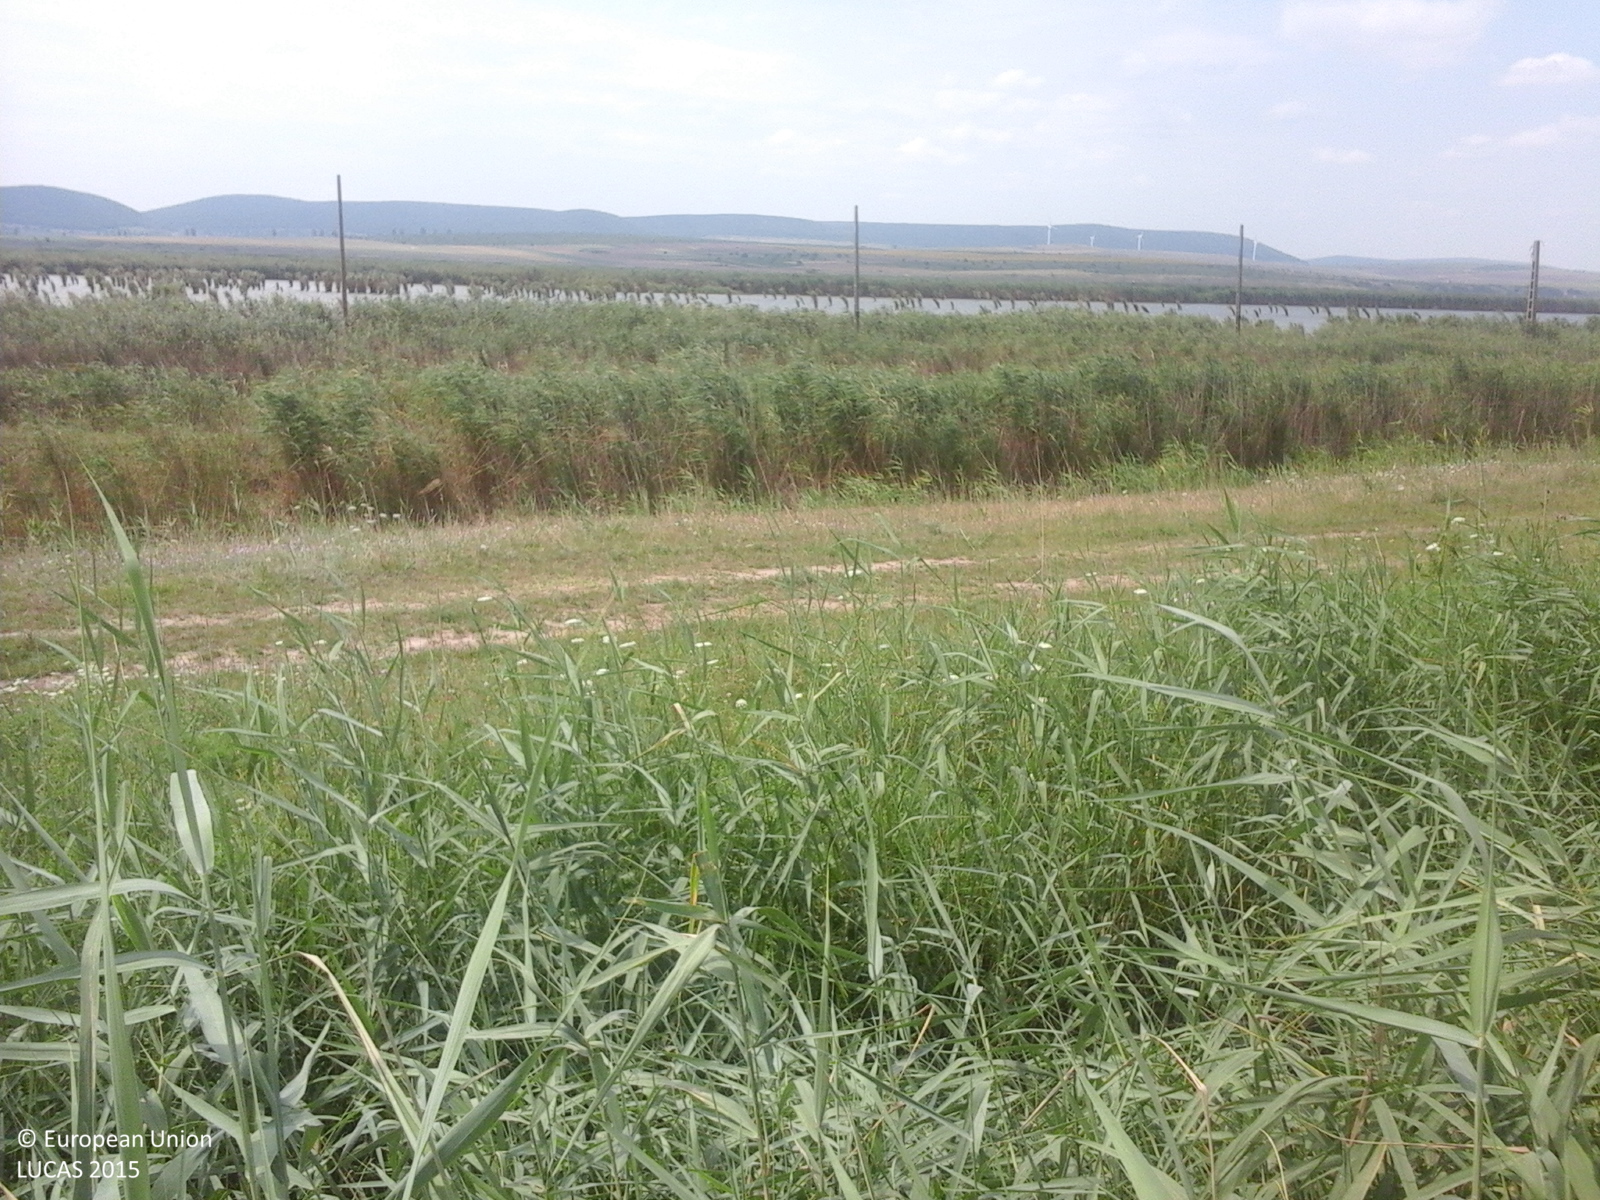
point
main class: Grassland
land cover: Grassland without tree/shrub cover
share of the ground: > 75 %
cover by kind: herbaceous plants 100 %
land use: Agriculture (excluding fallow land and kitchen gardens)
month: August
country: RO
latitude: 44.9013
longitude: 28.8181
